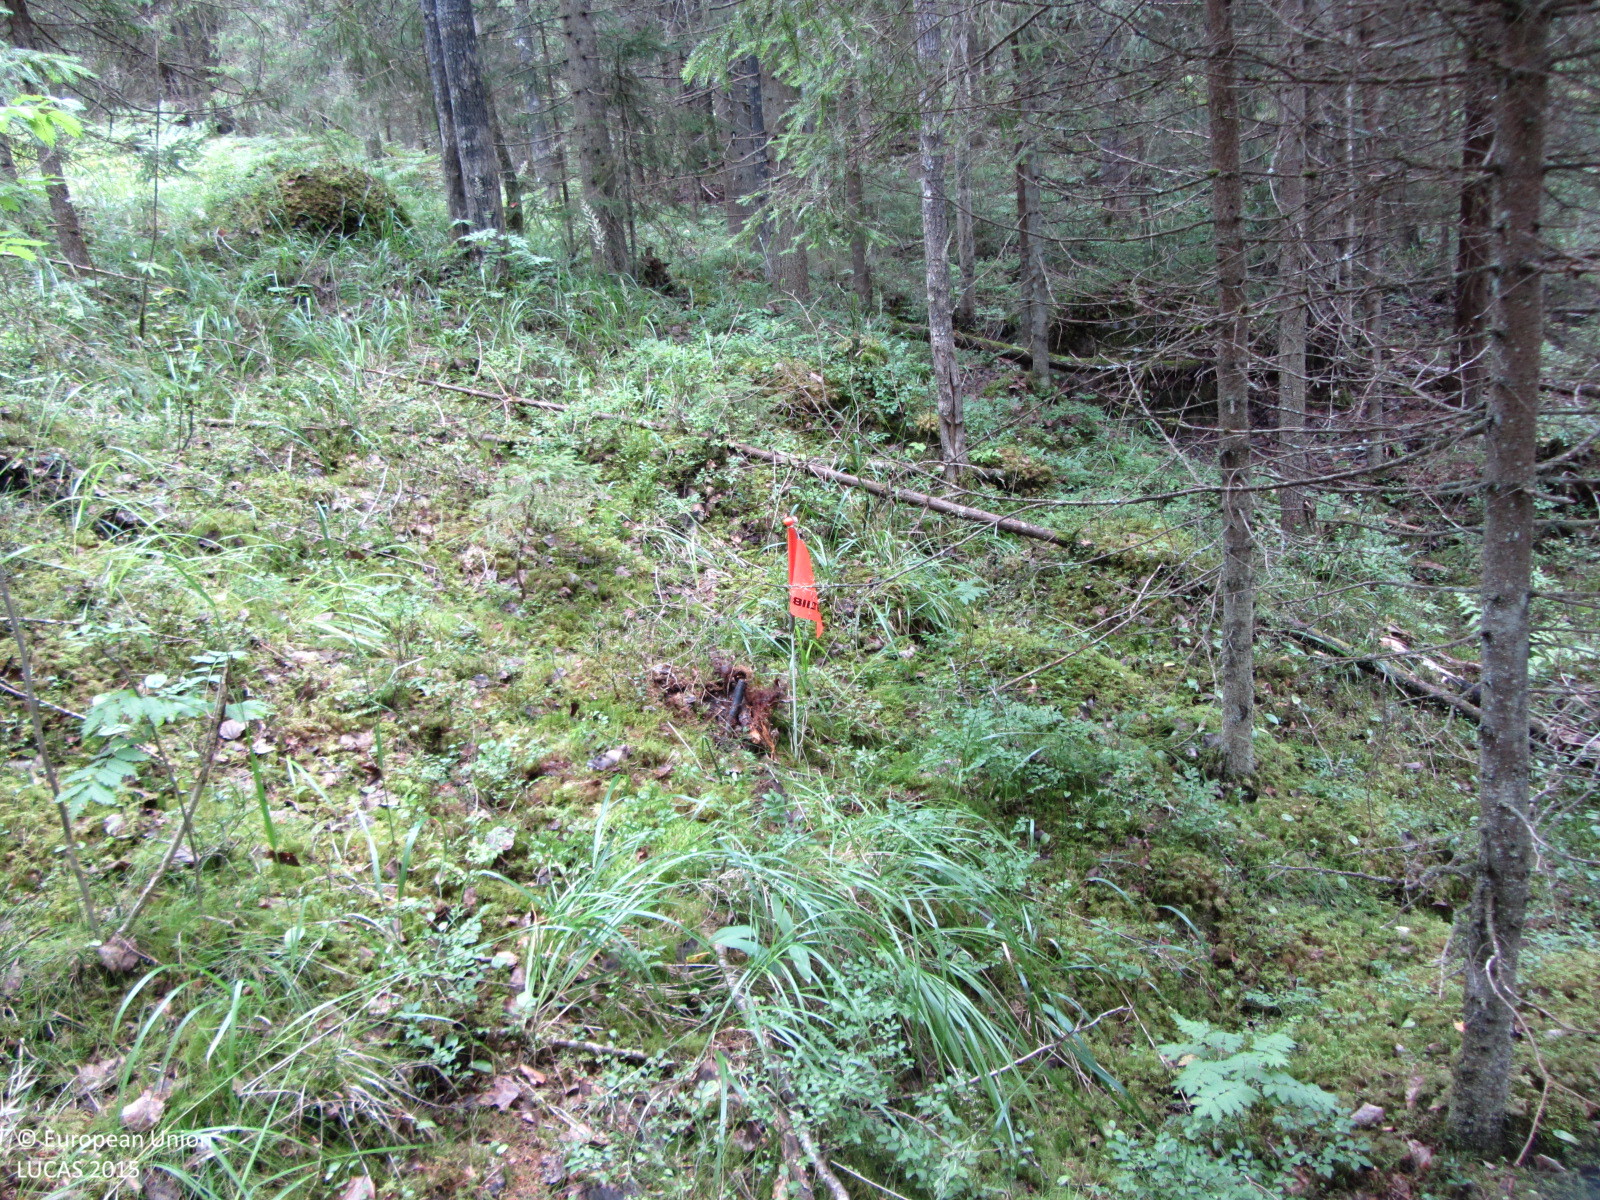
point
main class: Woodland
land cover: Spruce dominated coniferous woodland
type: boreal forest
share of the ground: > 75 %
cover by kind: coniferous forest trees 80 %, shrubs 10 %, broadleaved forest trees 5 %, herbaceous plants 5 %
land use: Forestry
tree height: > 5 m
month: August
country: FI
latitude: 60.6720
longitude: 24.6964
